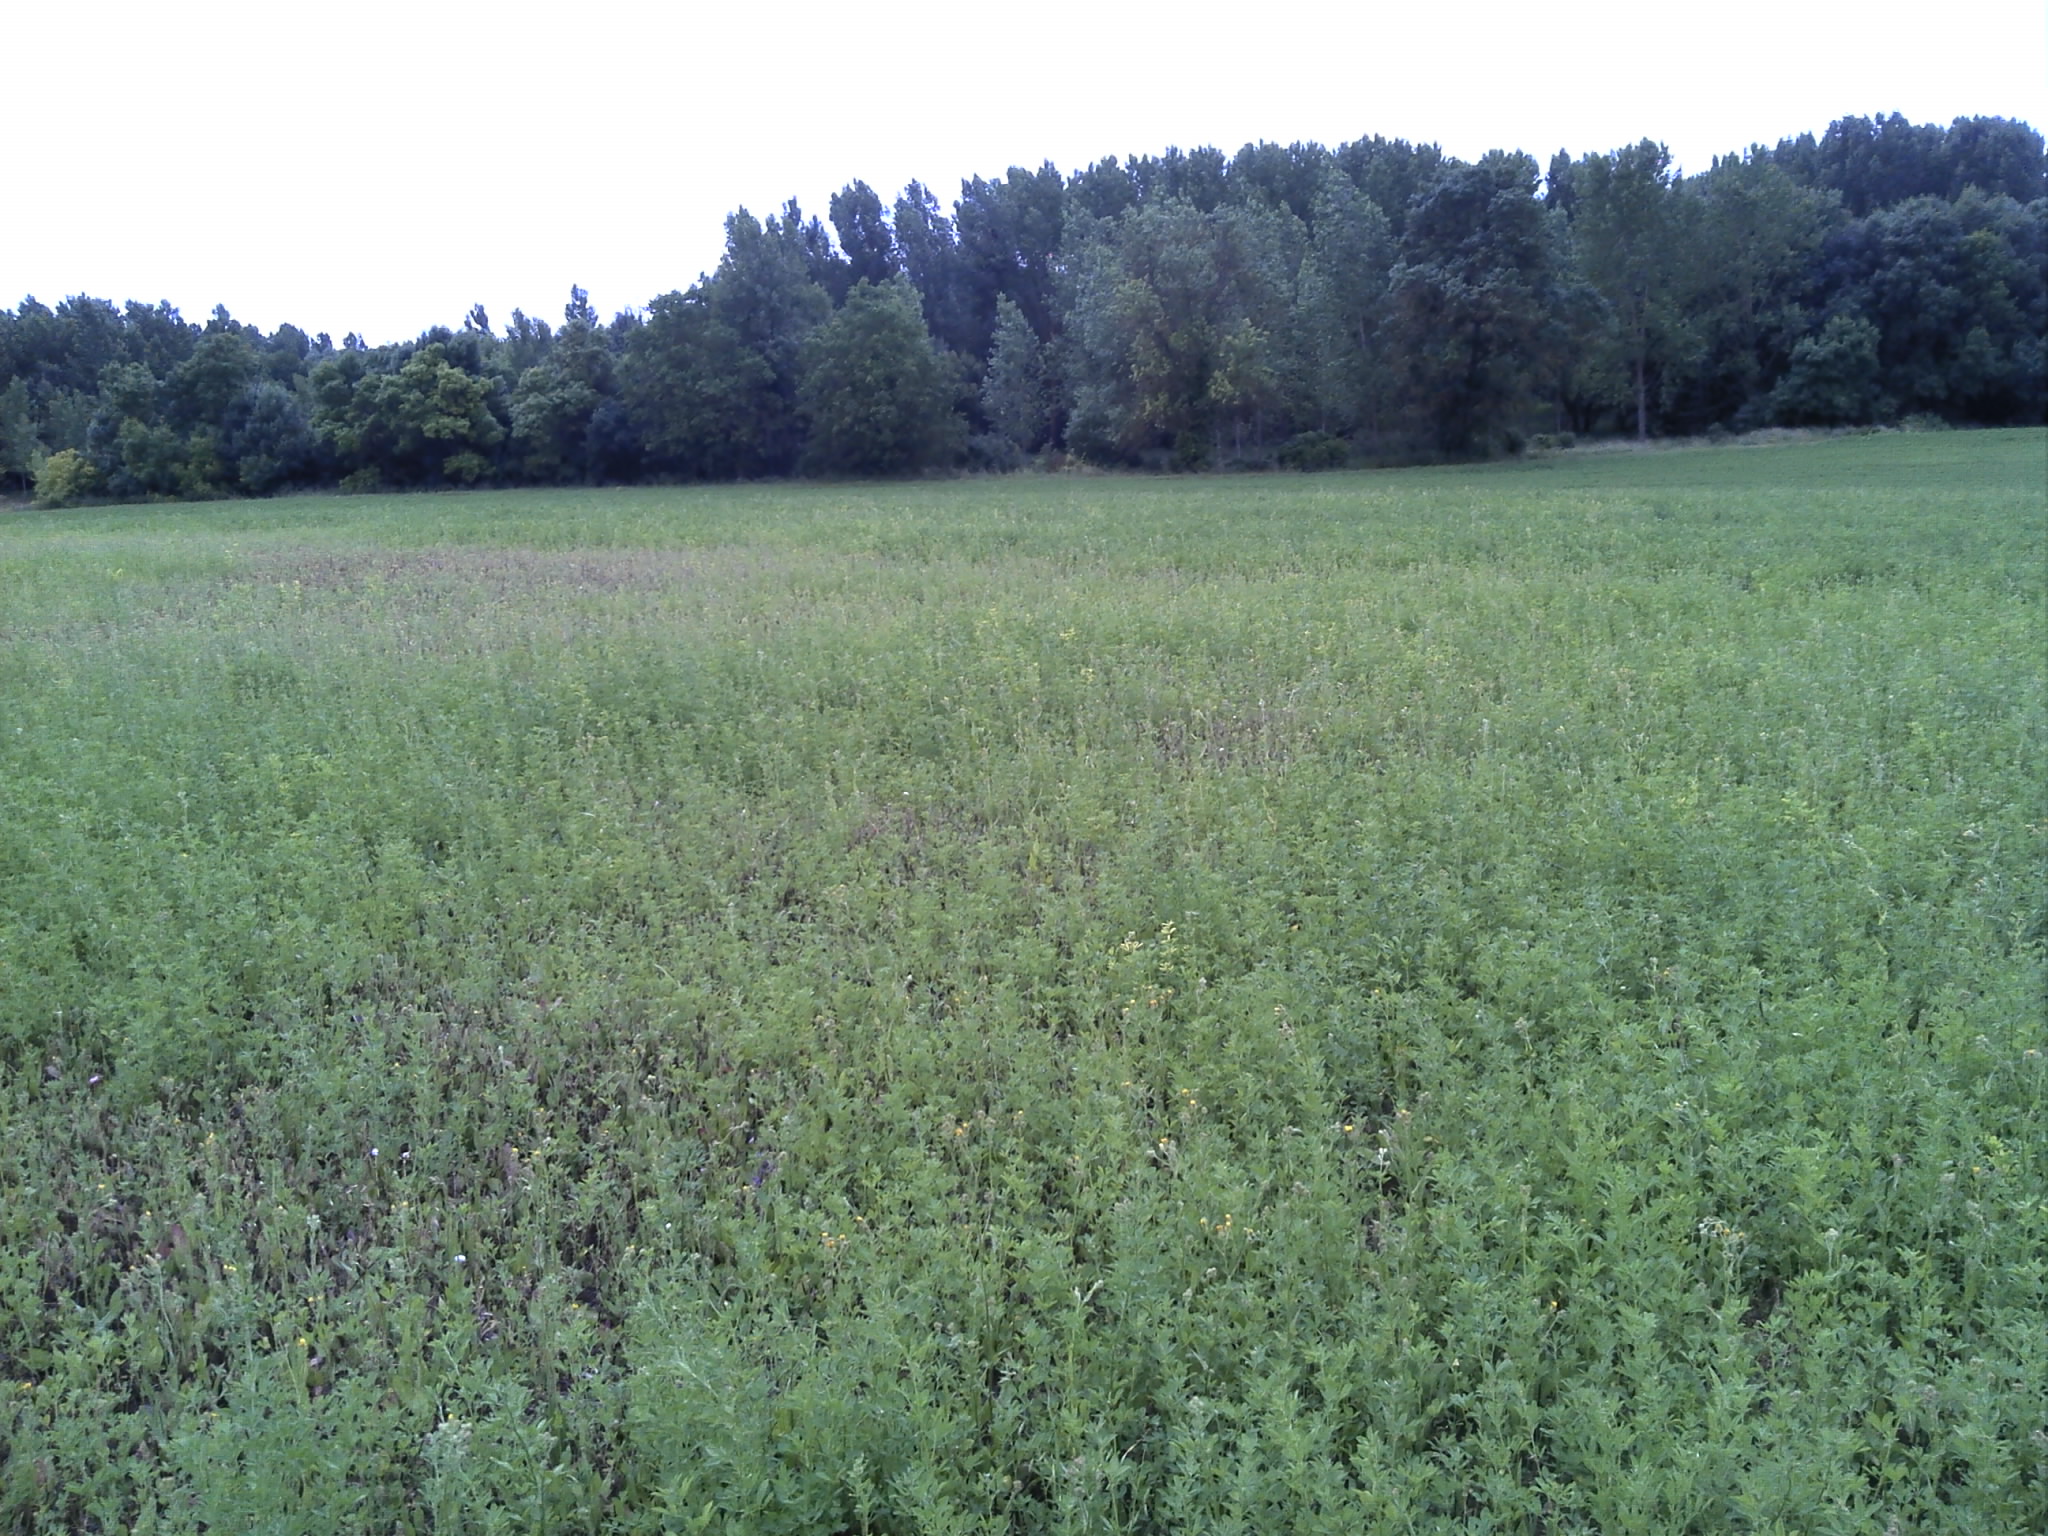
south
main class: Cropland
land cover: Lucerne
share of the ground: > 75 %
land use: Agriculture (excluding fallow land and kitchen gardens)
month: June
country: FR
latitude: 47.2489
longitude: 1.5711
